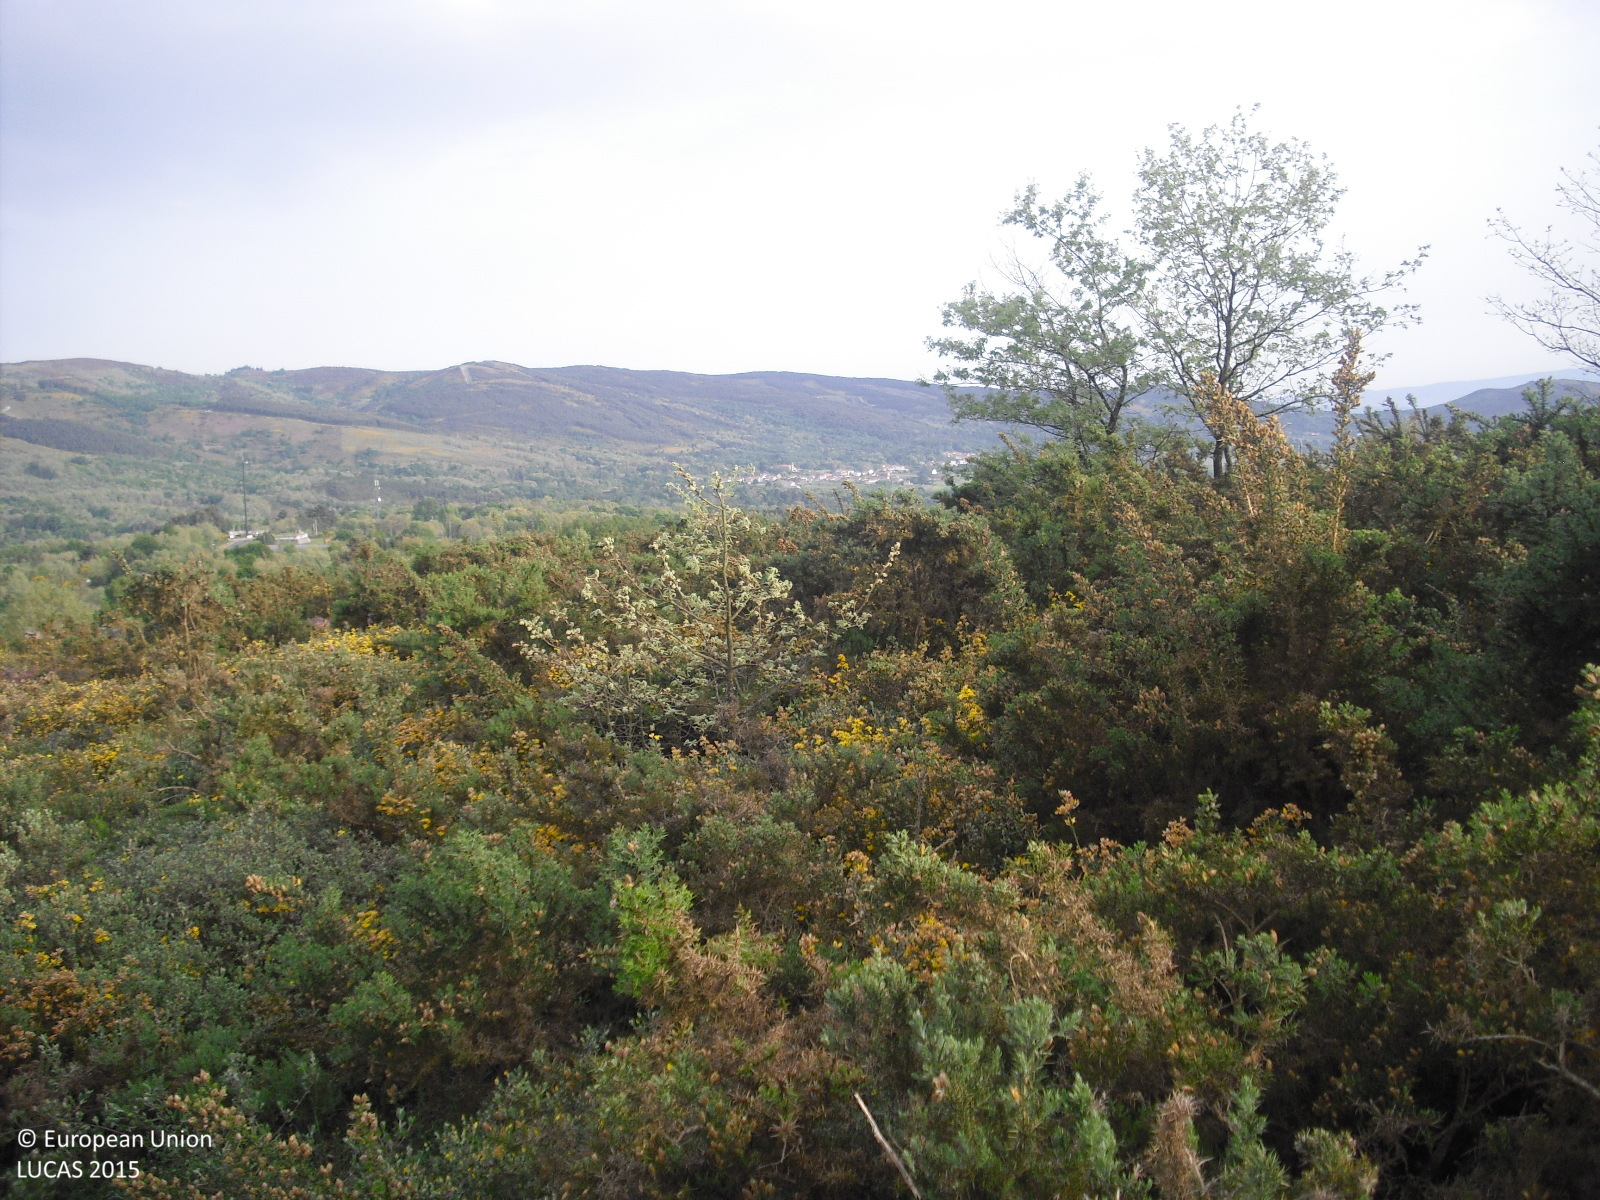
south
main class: Shrubland
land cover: Shrubland with sparse tree cover
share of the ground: > 75 %
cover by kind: shrubs 95 %, broadleaved forest trees 5 %
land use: Semi-natural and natural areas not in use
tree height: < 5 m
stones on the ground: 10 - 25 %
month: May
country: ES
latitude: 42.1668
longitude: -7.6070
